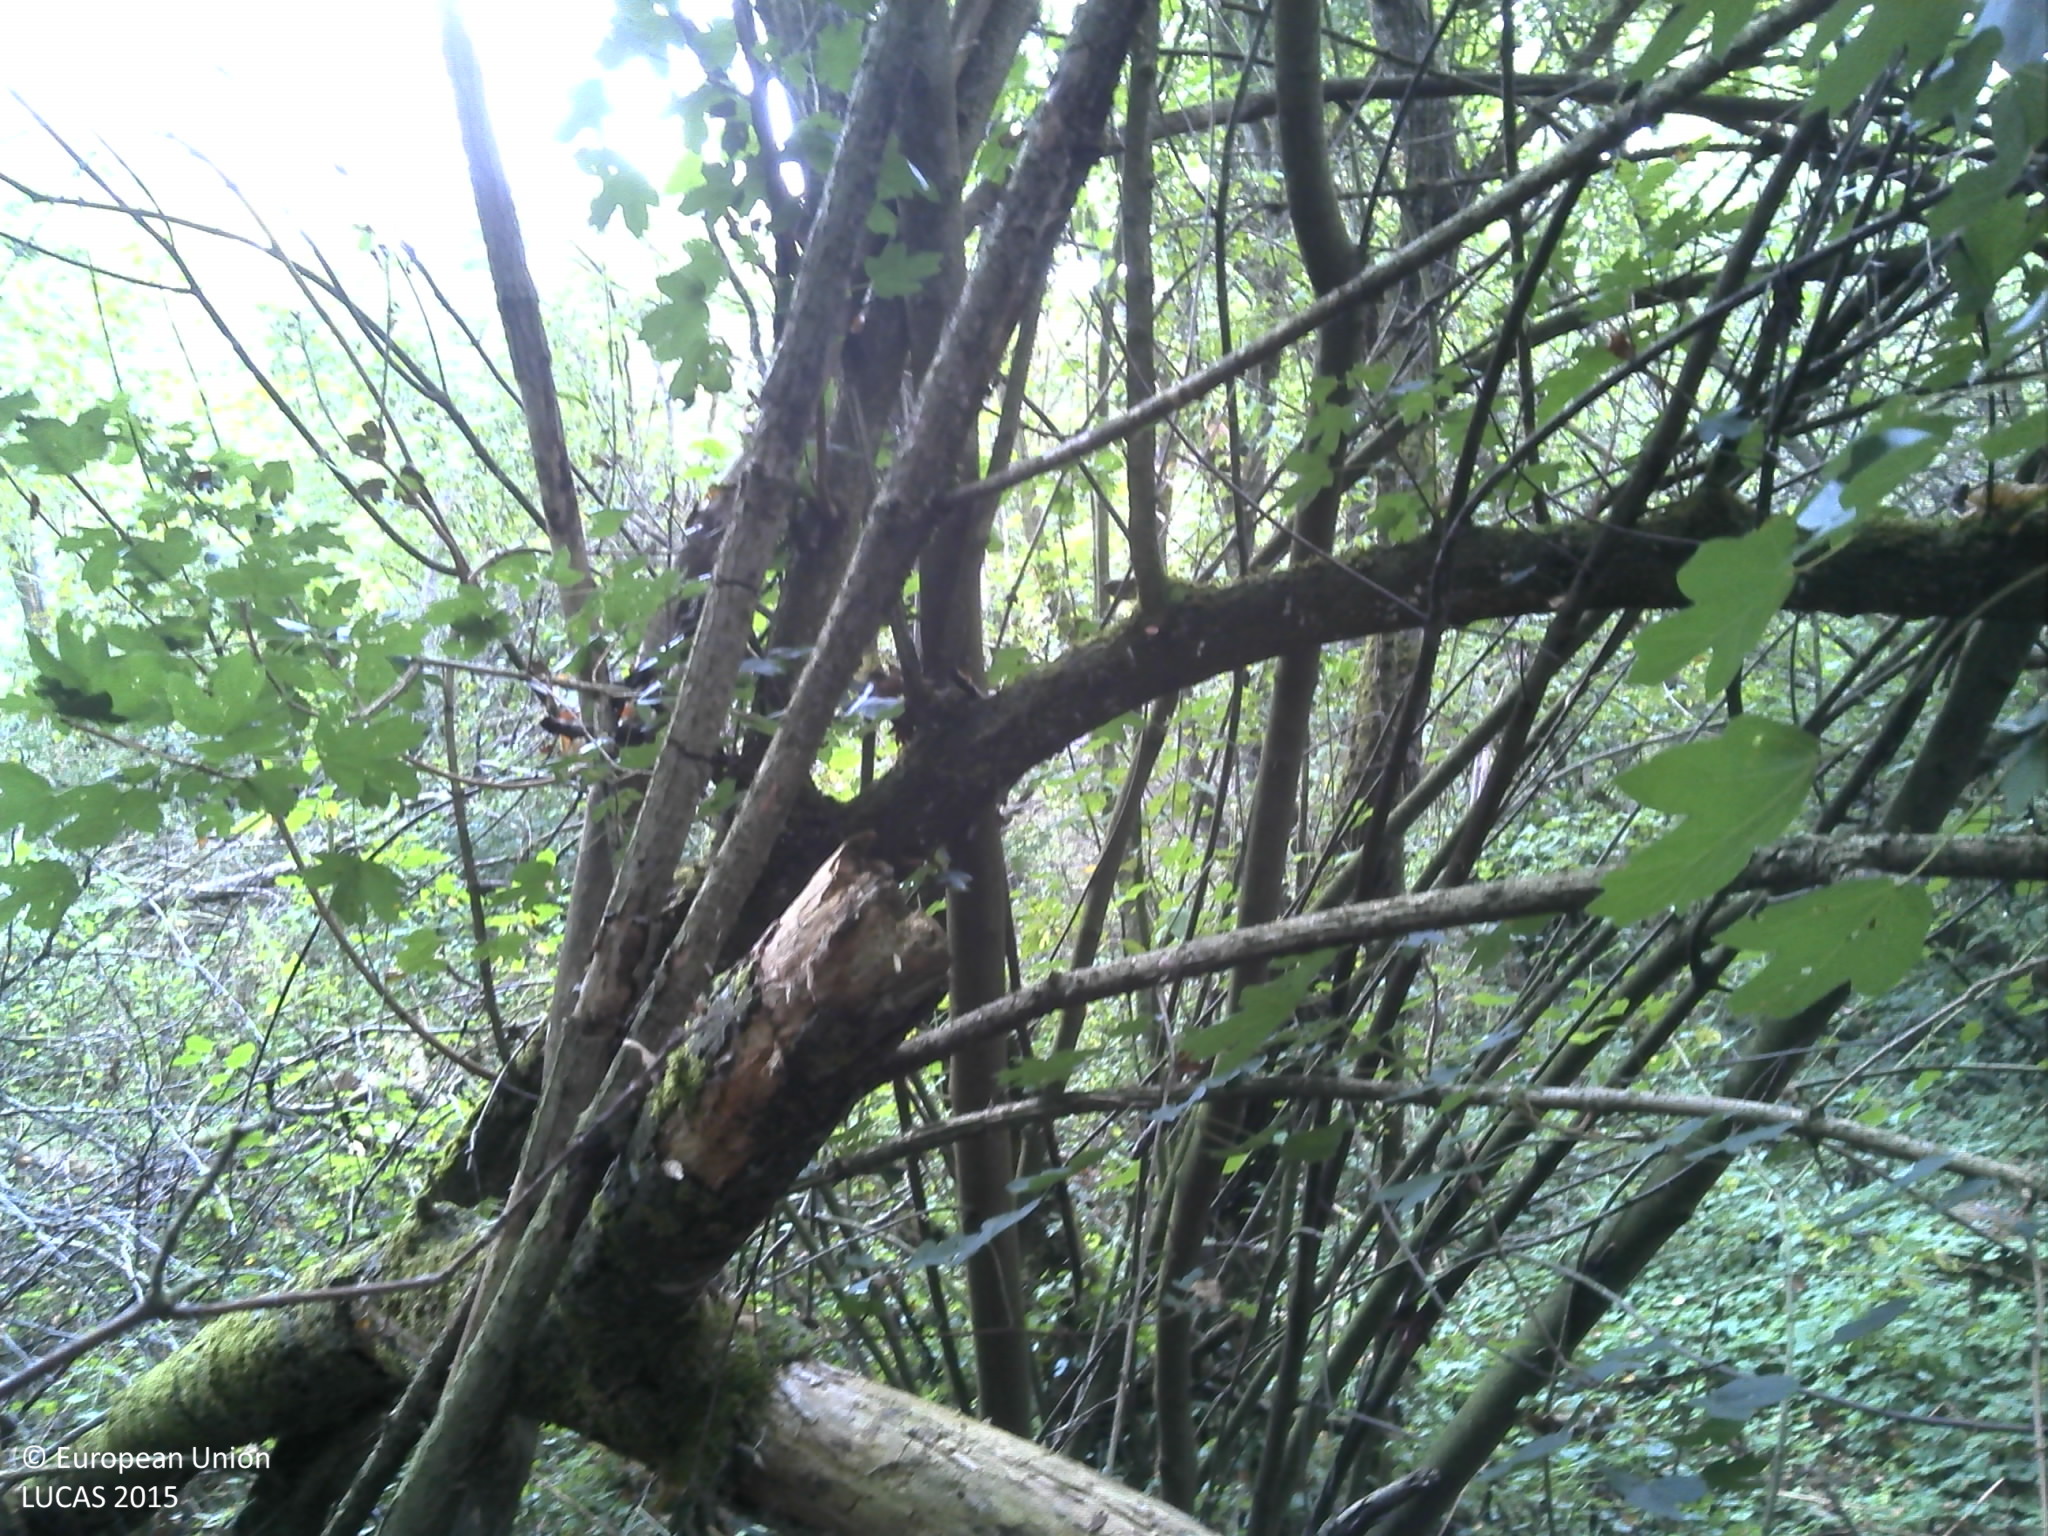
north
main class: Woodland
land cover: Broadleaved woodland
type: acidophilous oak and oak-birch forest
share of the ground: 10 - 25 %
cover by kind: shrubs 80 %, broadleaved forest trees 20 %
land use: Forestry
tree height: > 5 m
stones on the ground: < 10 %
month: August
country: HR
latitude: 45.3430
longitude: 18.0307
